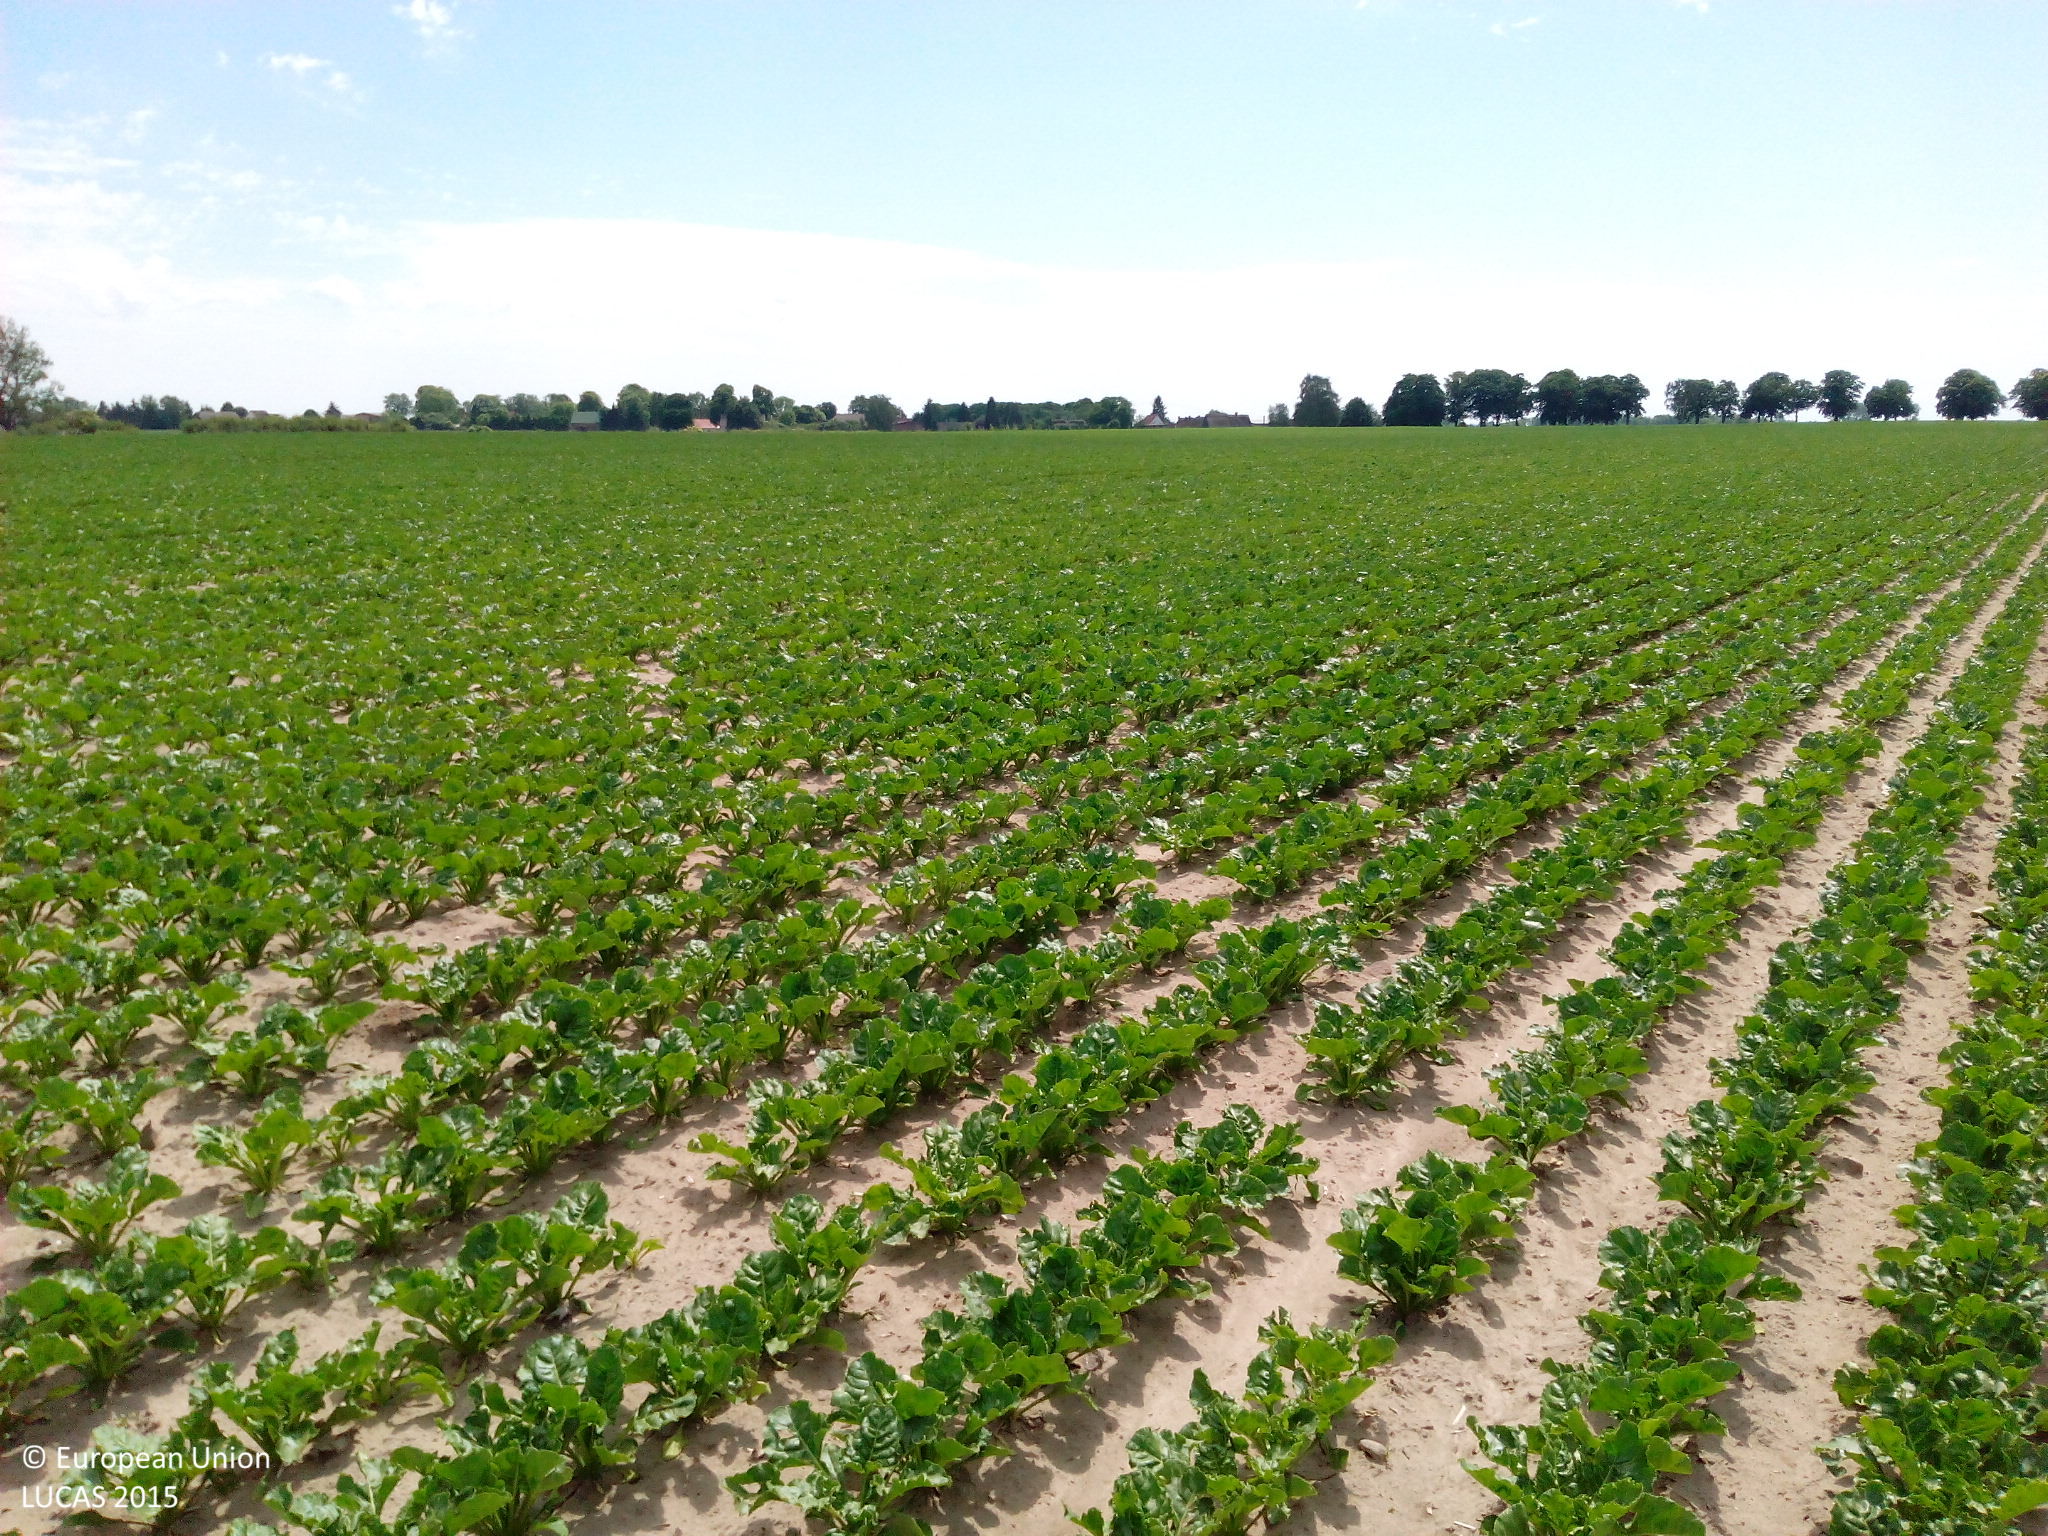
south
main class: Cropland
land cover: Sugar beet
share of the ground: 50 - 75 %
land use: Agriculture (excluding fallow land and kitchen gardens)
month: June
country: DE
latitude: 53.8476
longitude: 13.7543
